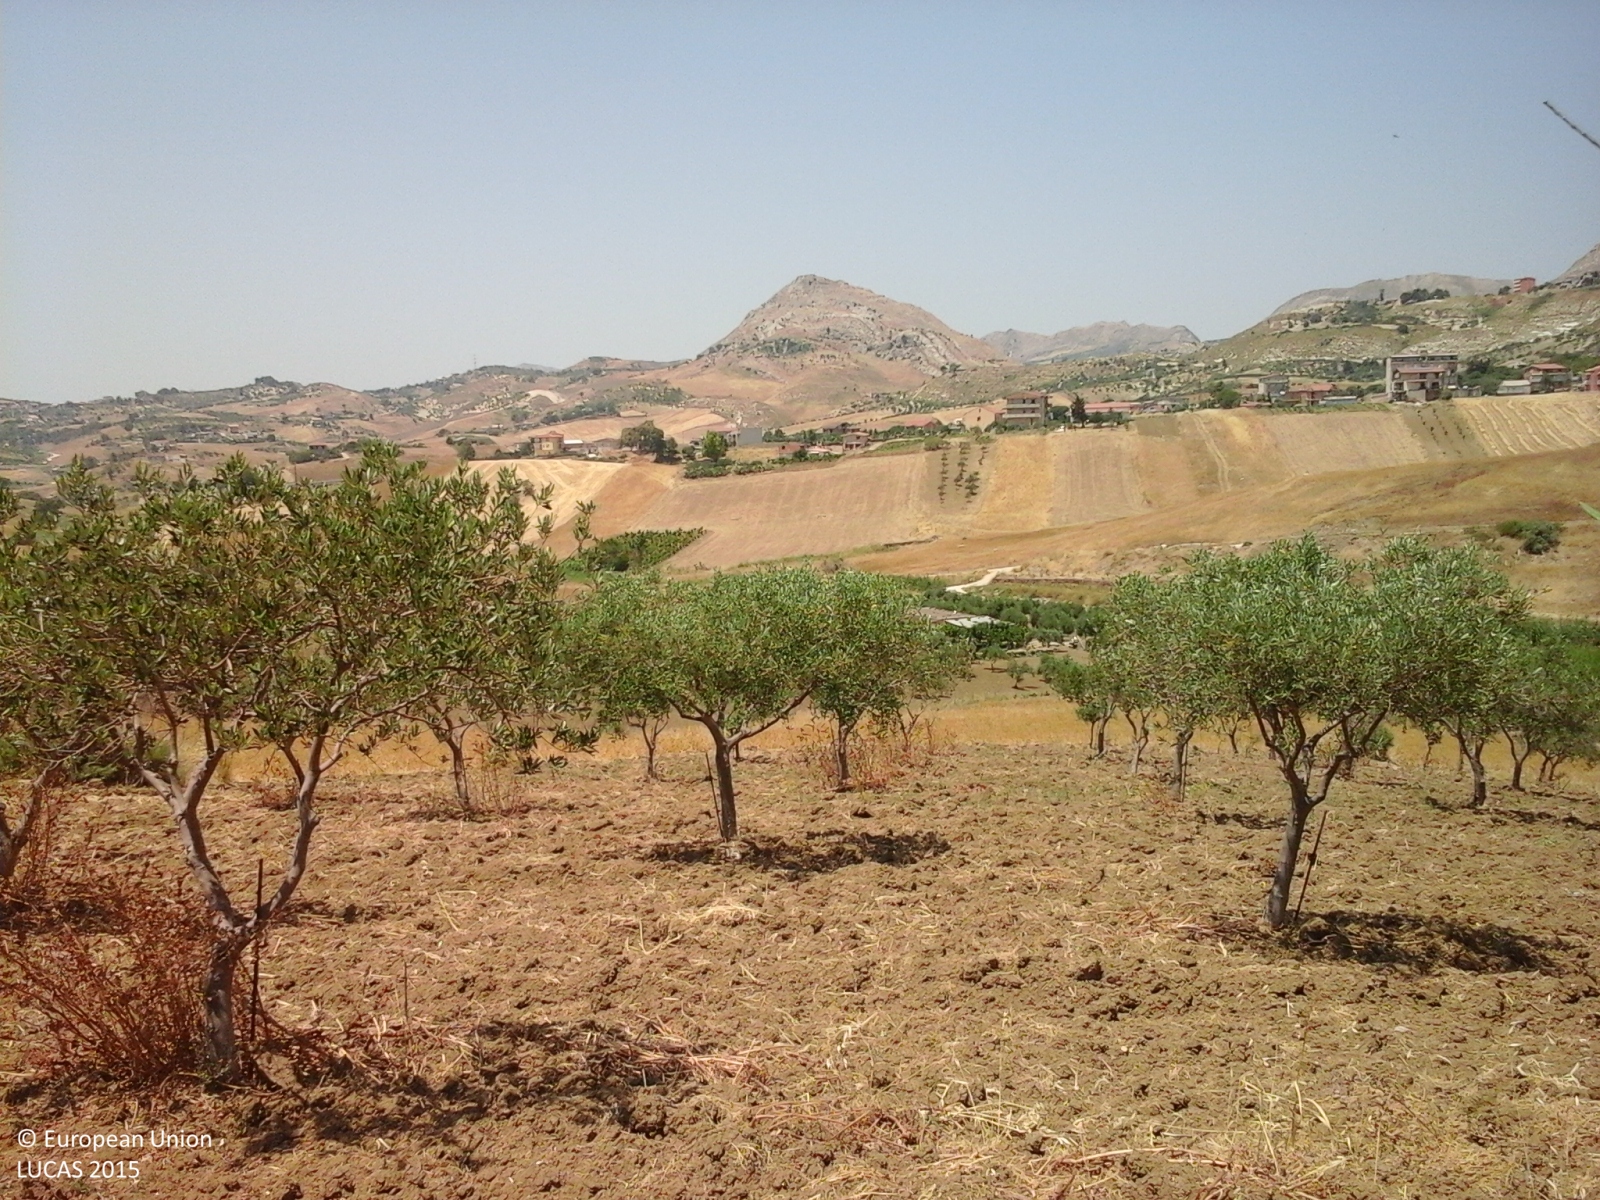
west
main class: Cropland
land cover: Olive groves
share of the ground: 25 - 50 %
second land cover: Other bare soil
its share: > 75 %
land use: Agriculture (excluding fallow land and kitchen gardens)
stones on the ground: < 10 %
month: July
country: IT
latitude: 37.4267
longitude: 13.5549
